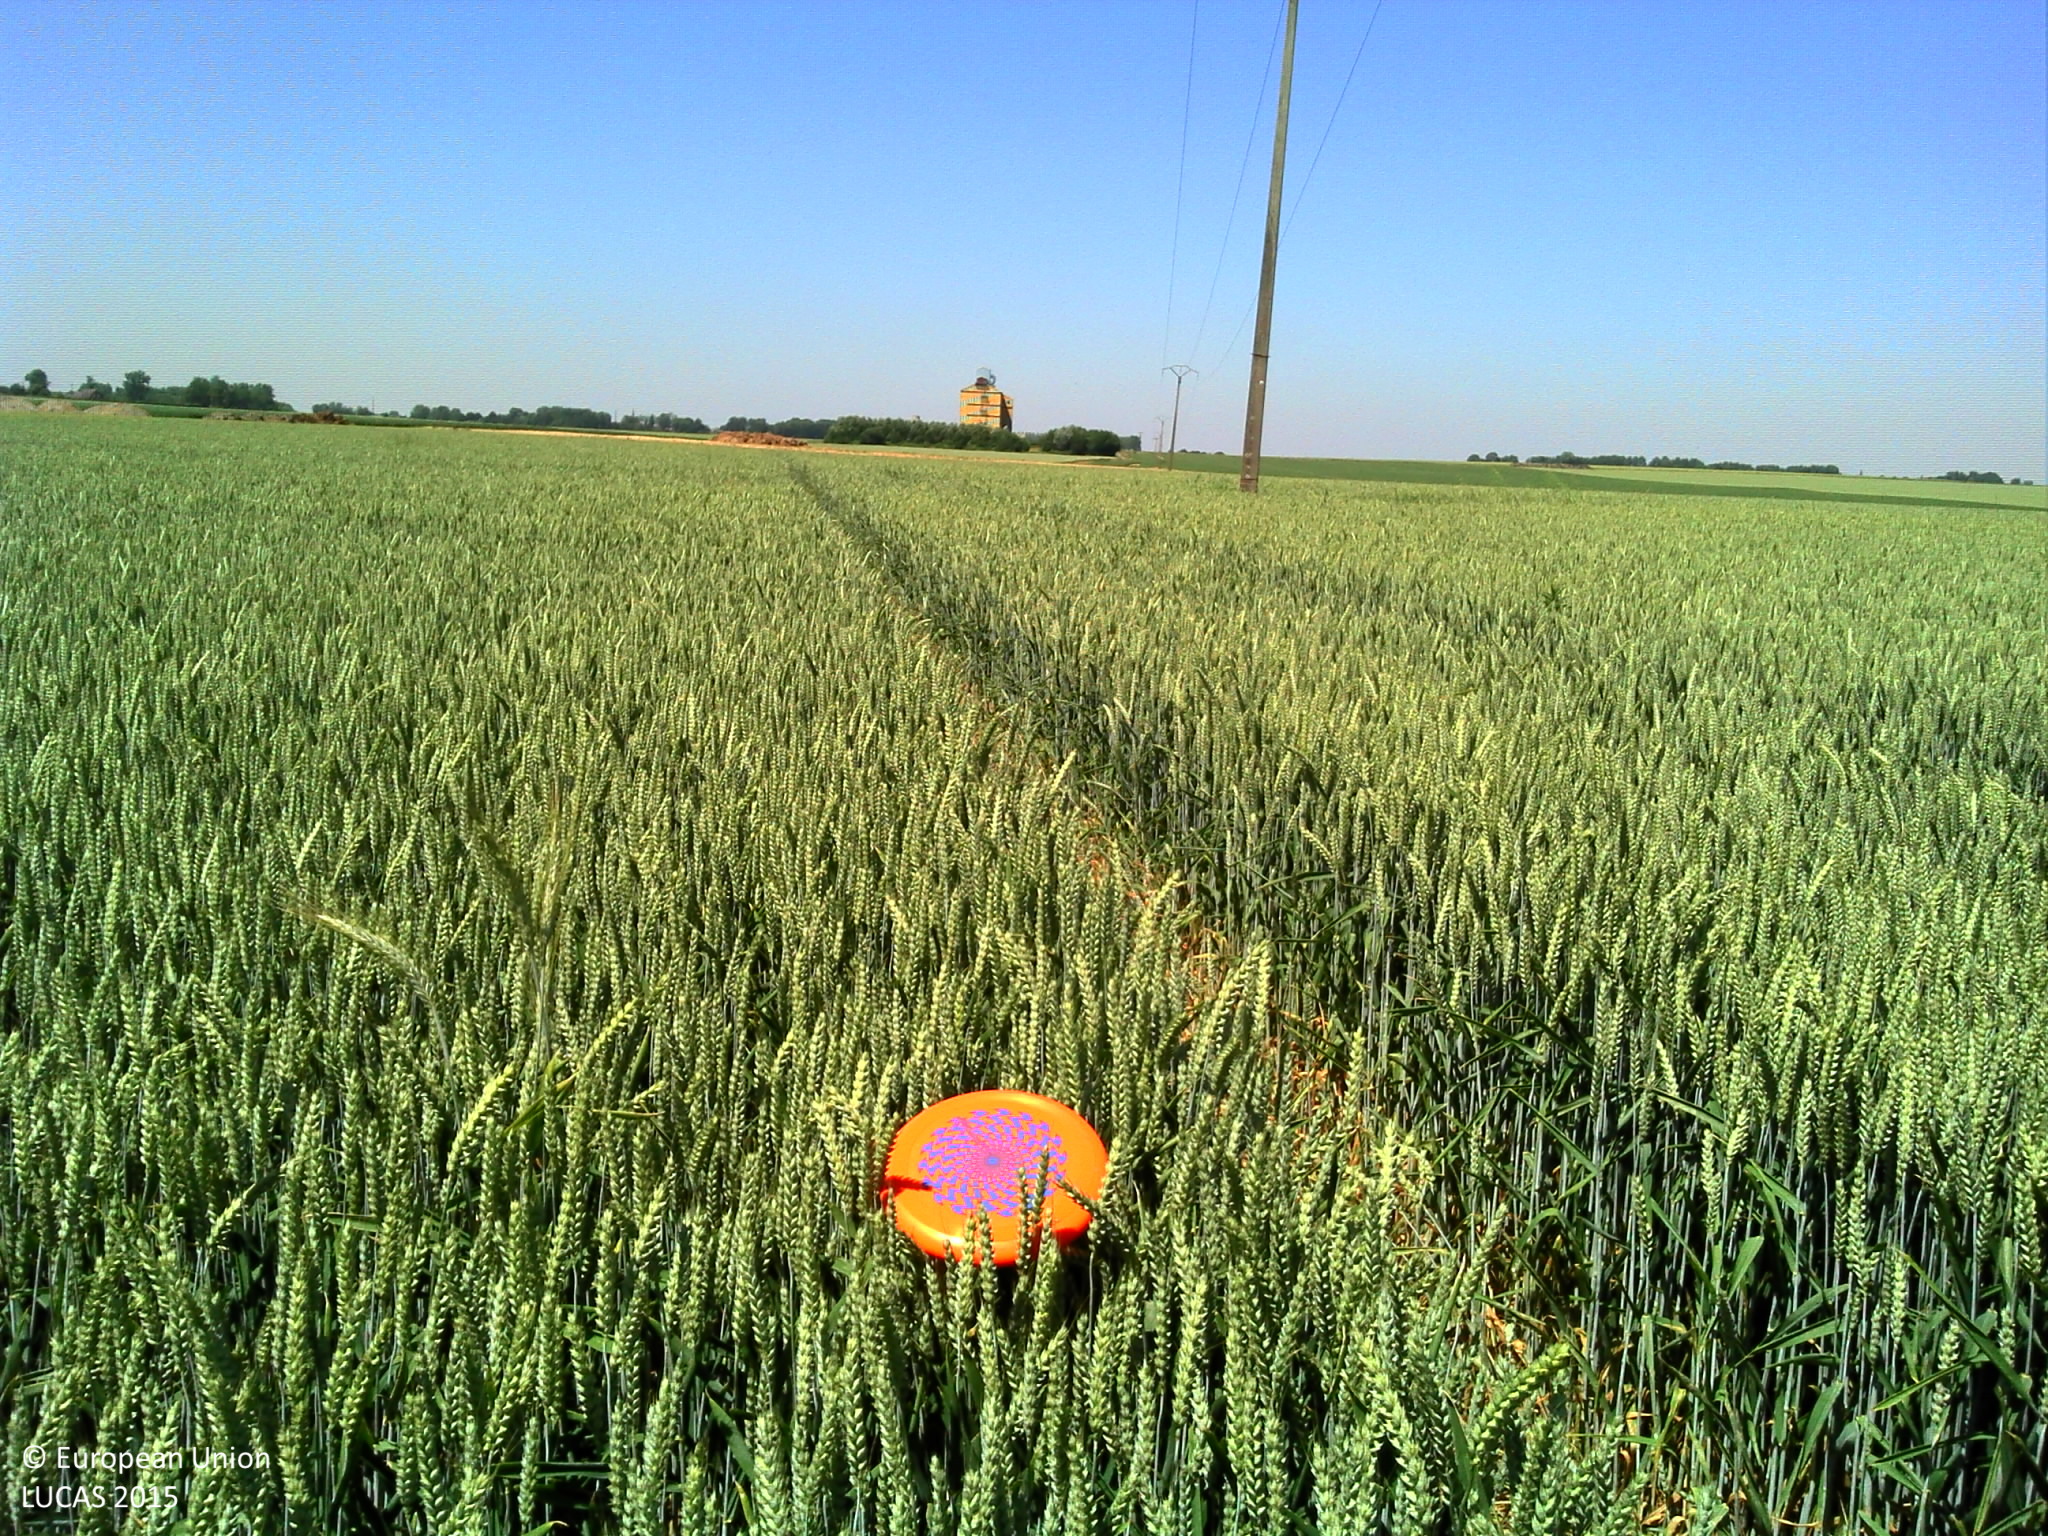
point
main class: Cropland
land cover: Common wheat
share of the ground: > 75 %
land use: Agriculture (excluding fallow land and kitchen gardens)
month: June
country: FR
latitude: 50.3269
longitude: 2.3874
